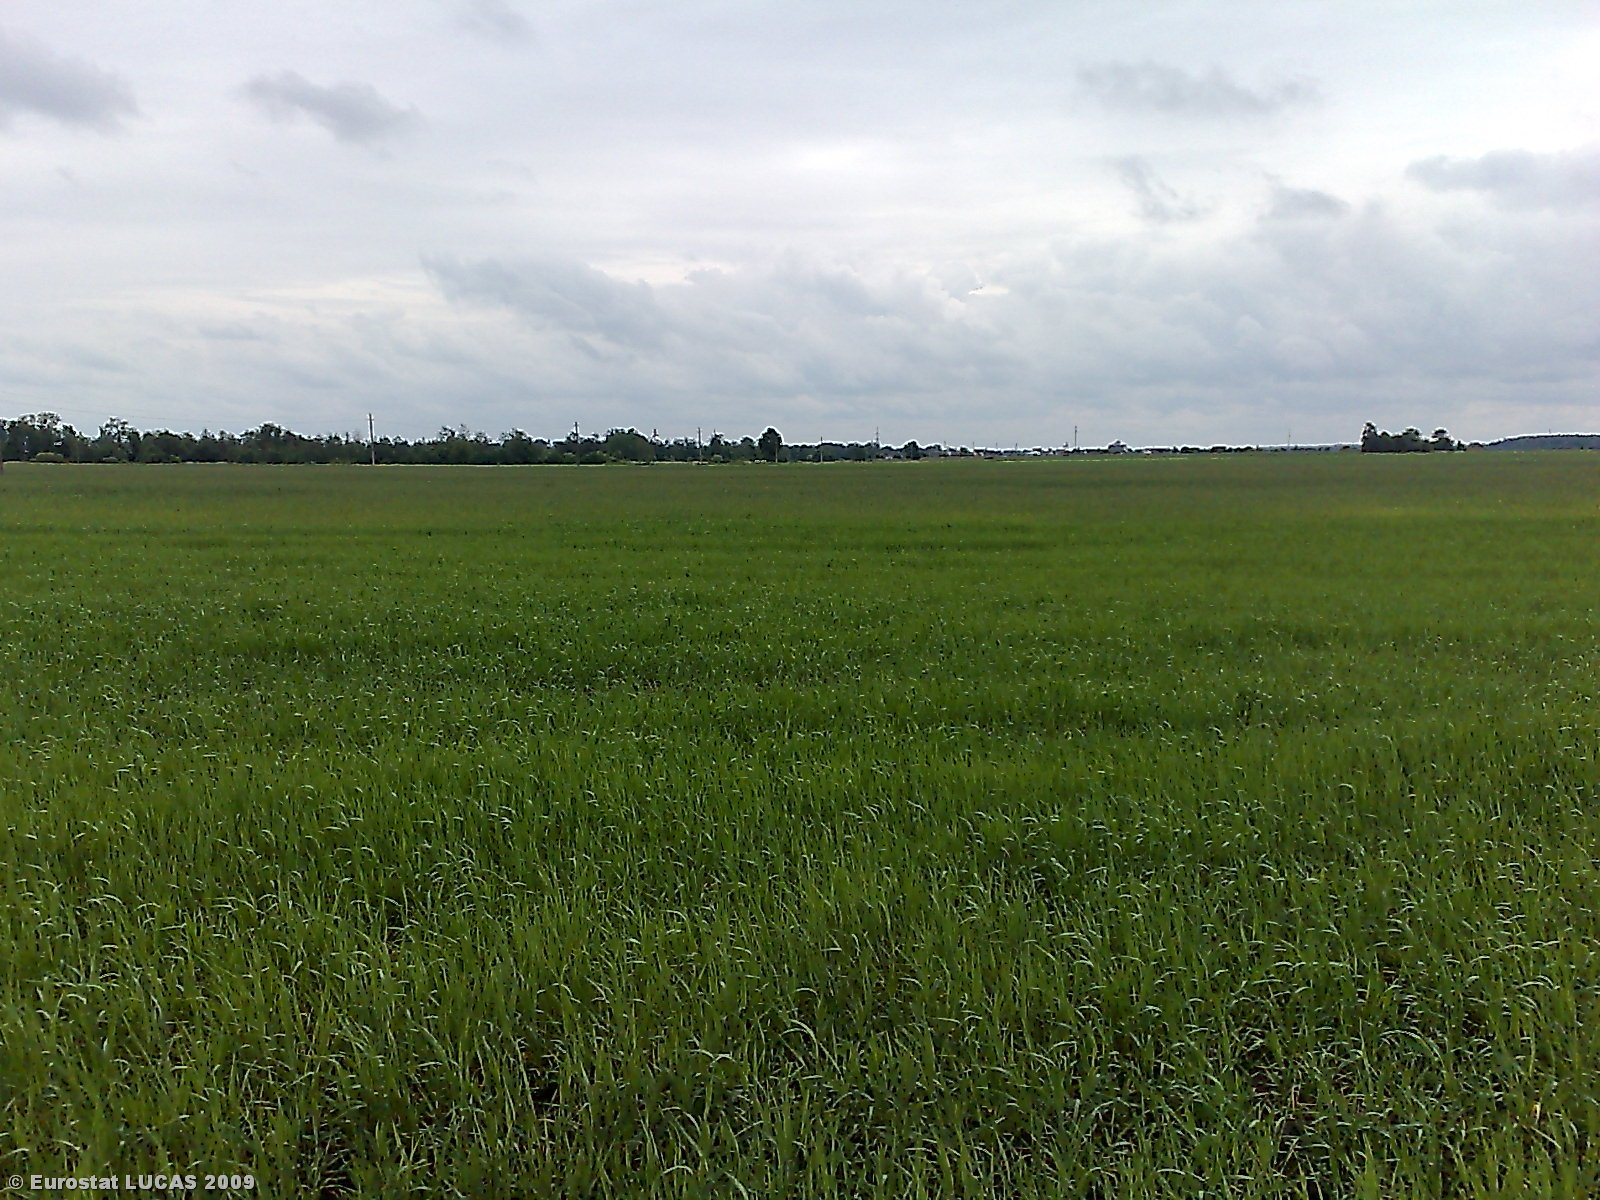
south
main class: Cropland
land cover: Barley
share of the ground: > 75 %
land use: Agriculture (excluding fallow land and kitchen gardens)
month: June
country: LT
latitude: 55.9695
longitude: 23.9454
